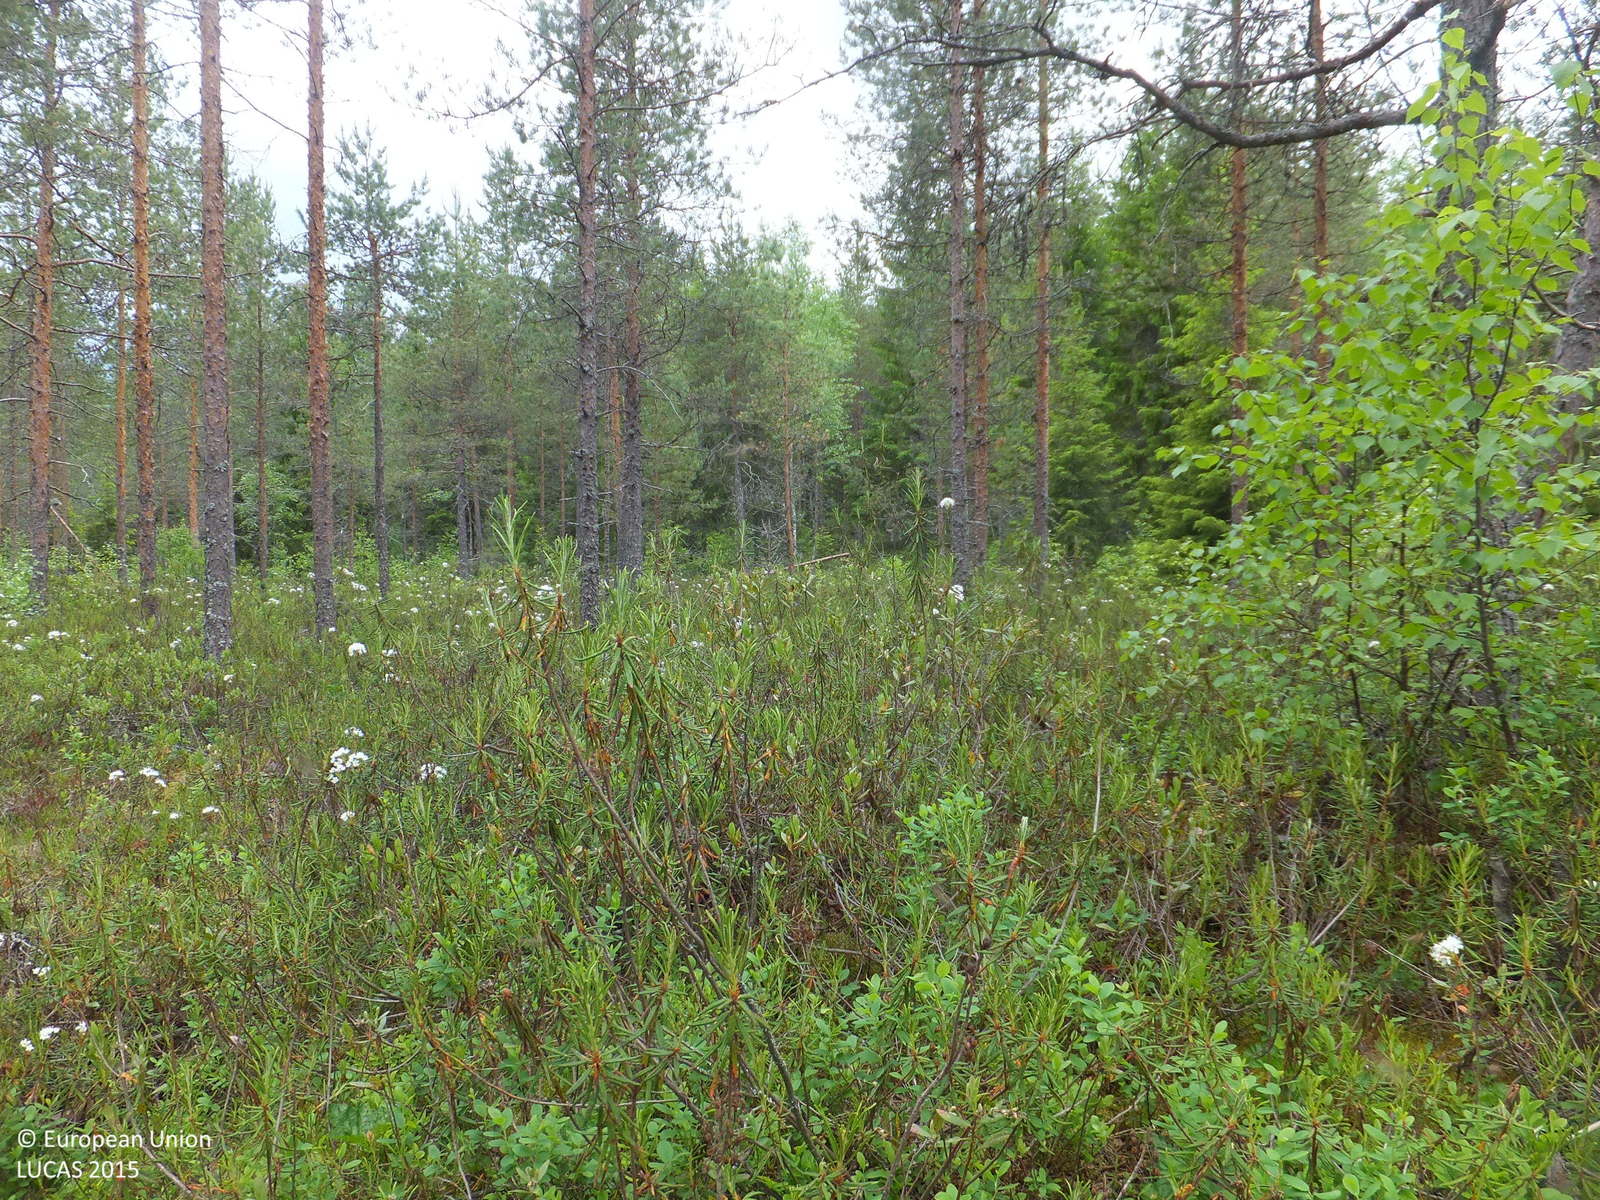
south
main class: Woodland
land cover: Pine dominated mixed woodland
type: boreal forest
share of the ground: 50 - 75 %
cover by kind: coniferous forest trees 40 %, shrubs 30 %, broadleaved forest trees 25 %, lichens and mosses 5 %
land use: Forestry
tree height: > 5 m
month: June
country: FI
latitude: 63.5193
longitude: 24.1644
